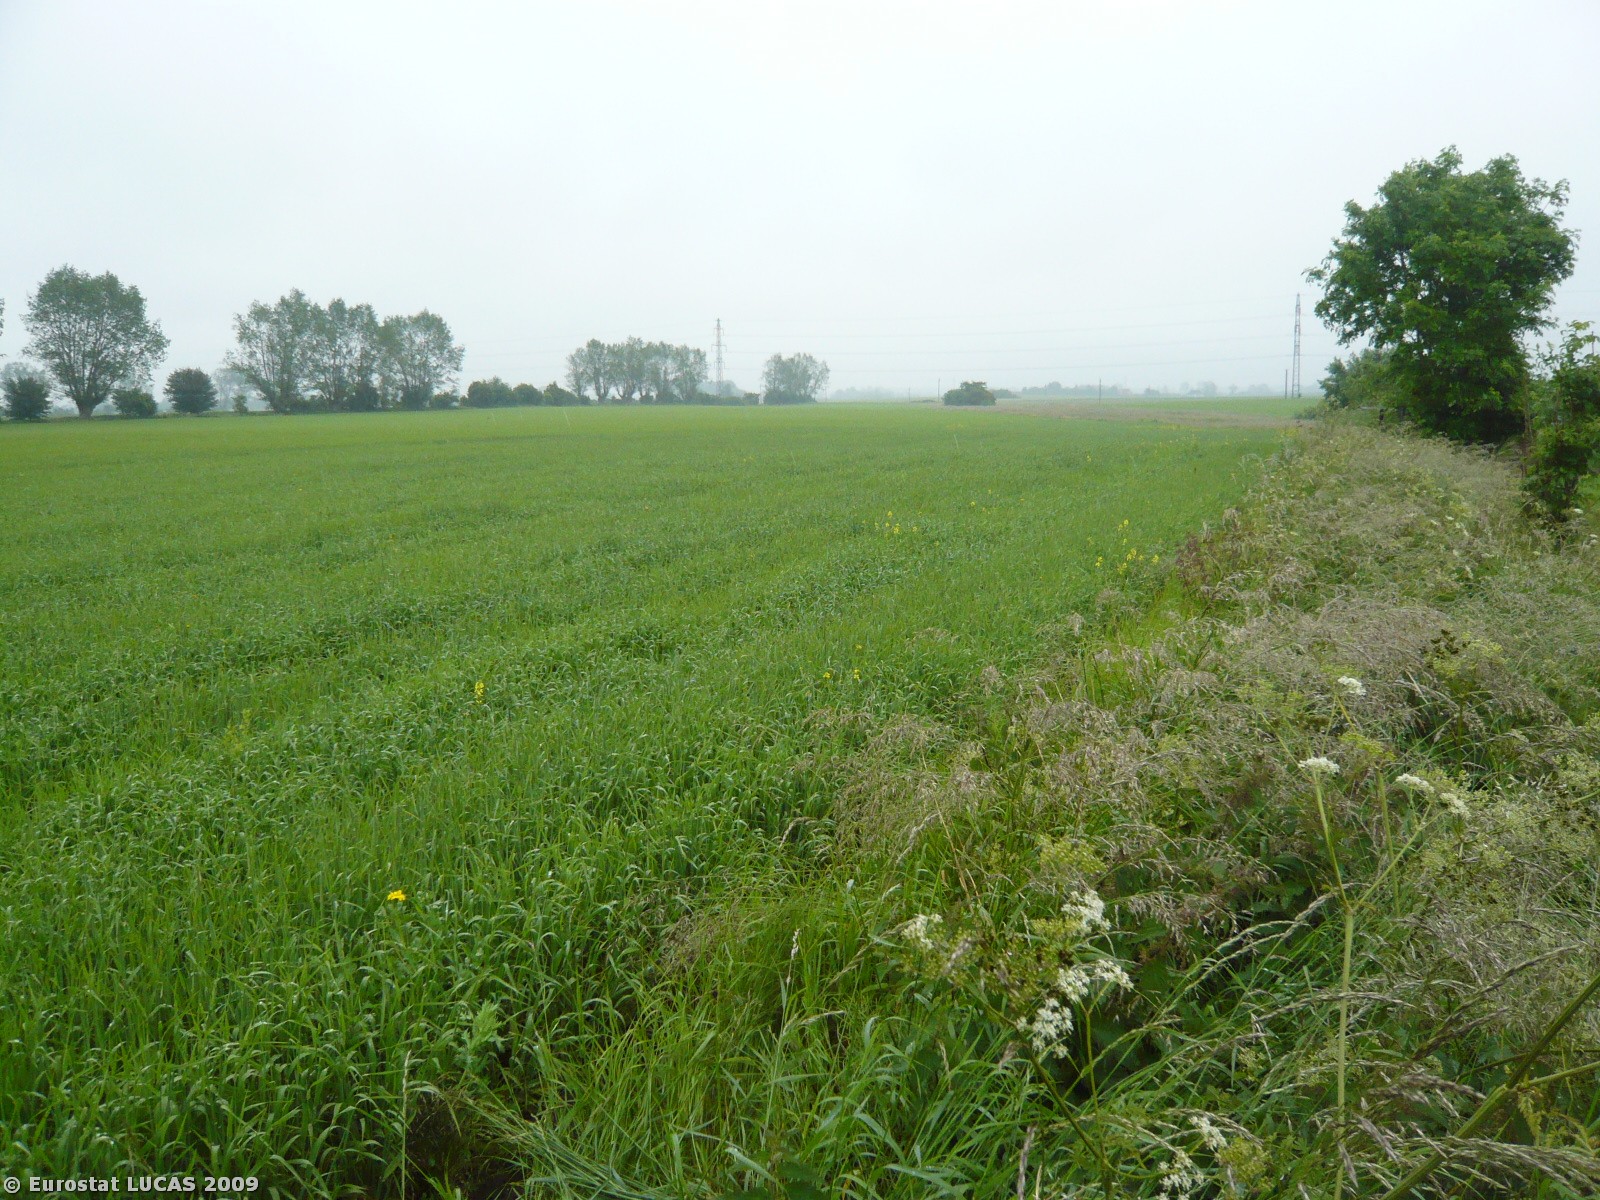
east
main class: Grassland
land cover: Grassland without tree/shrub cover
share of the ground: > 75 %
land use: Railway transport
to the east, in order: Grassland without tree/shrub cover; Barley; Grassland without tree/shrub cover
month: June
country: DK
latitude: 54.7923
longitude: 11.6941
